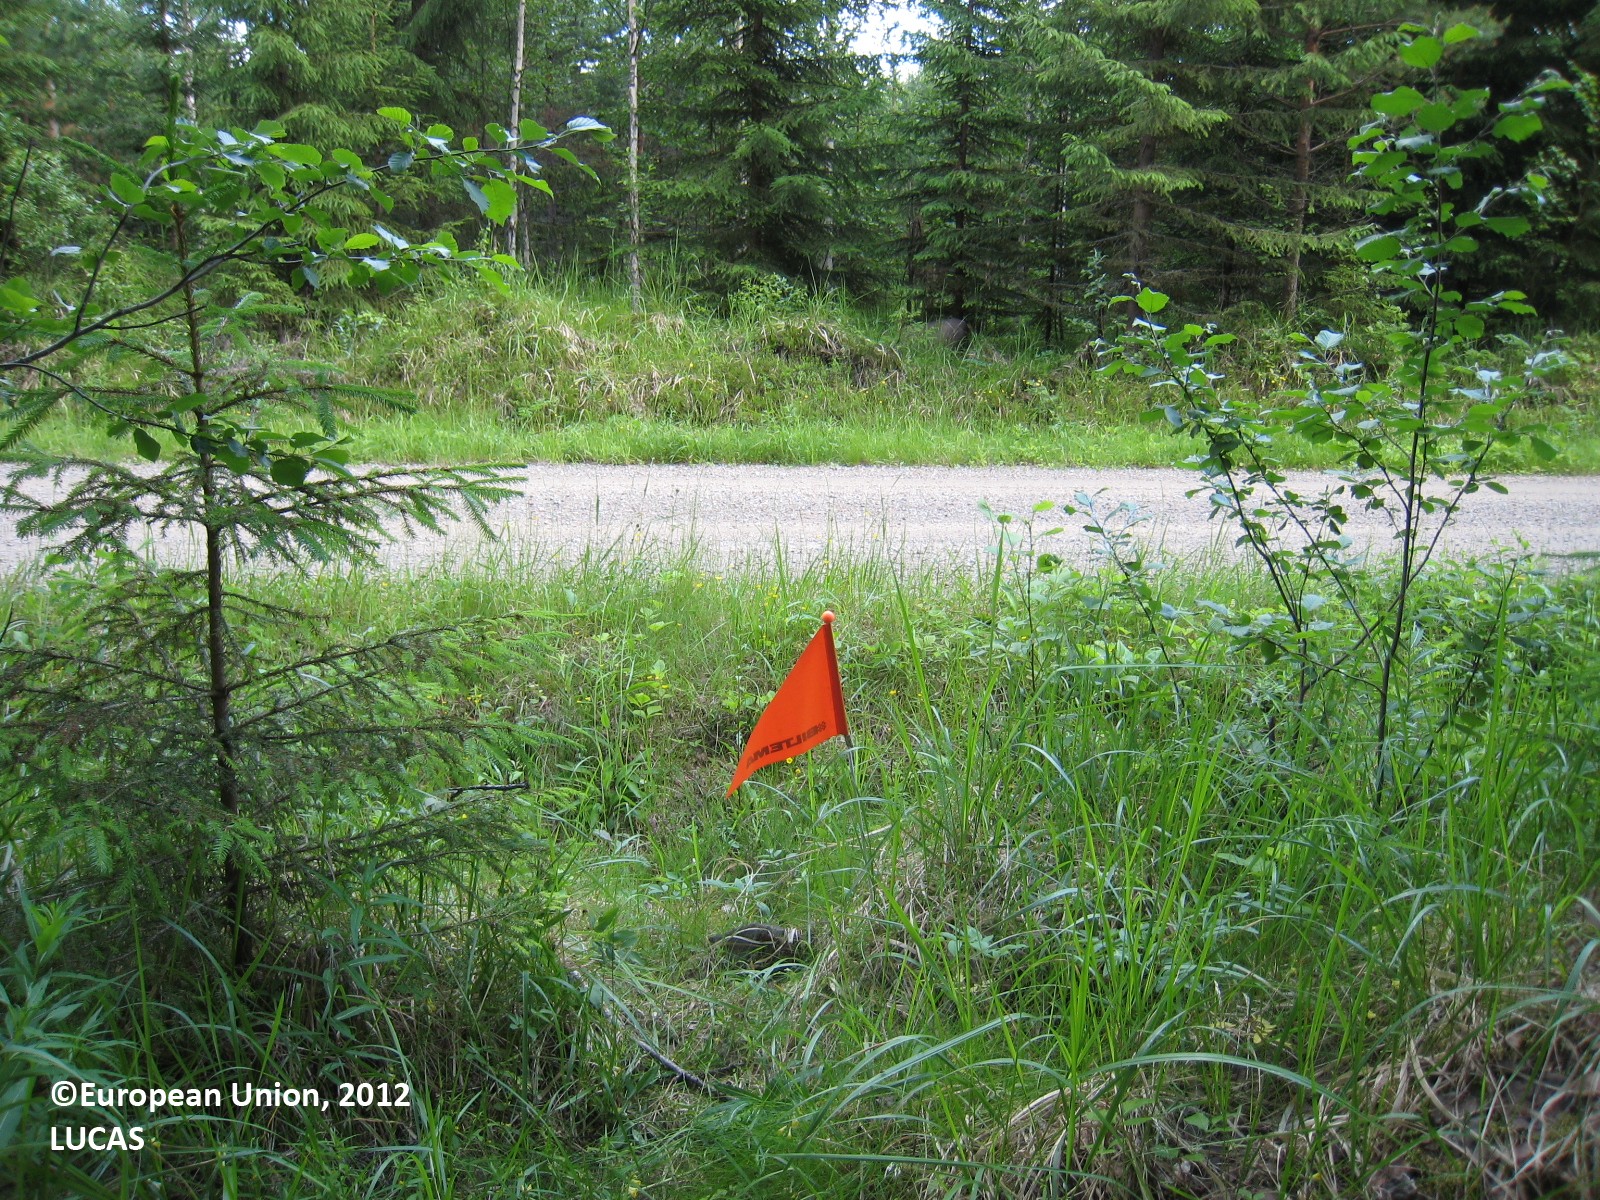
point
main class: Woodland
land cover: Other mixed woodland
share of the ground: 50 - 75 %
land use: Forestry
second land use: Road transport
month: July
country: FI
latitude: 63.2226
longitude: 25.6868
